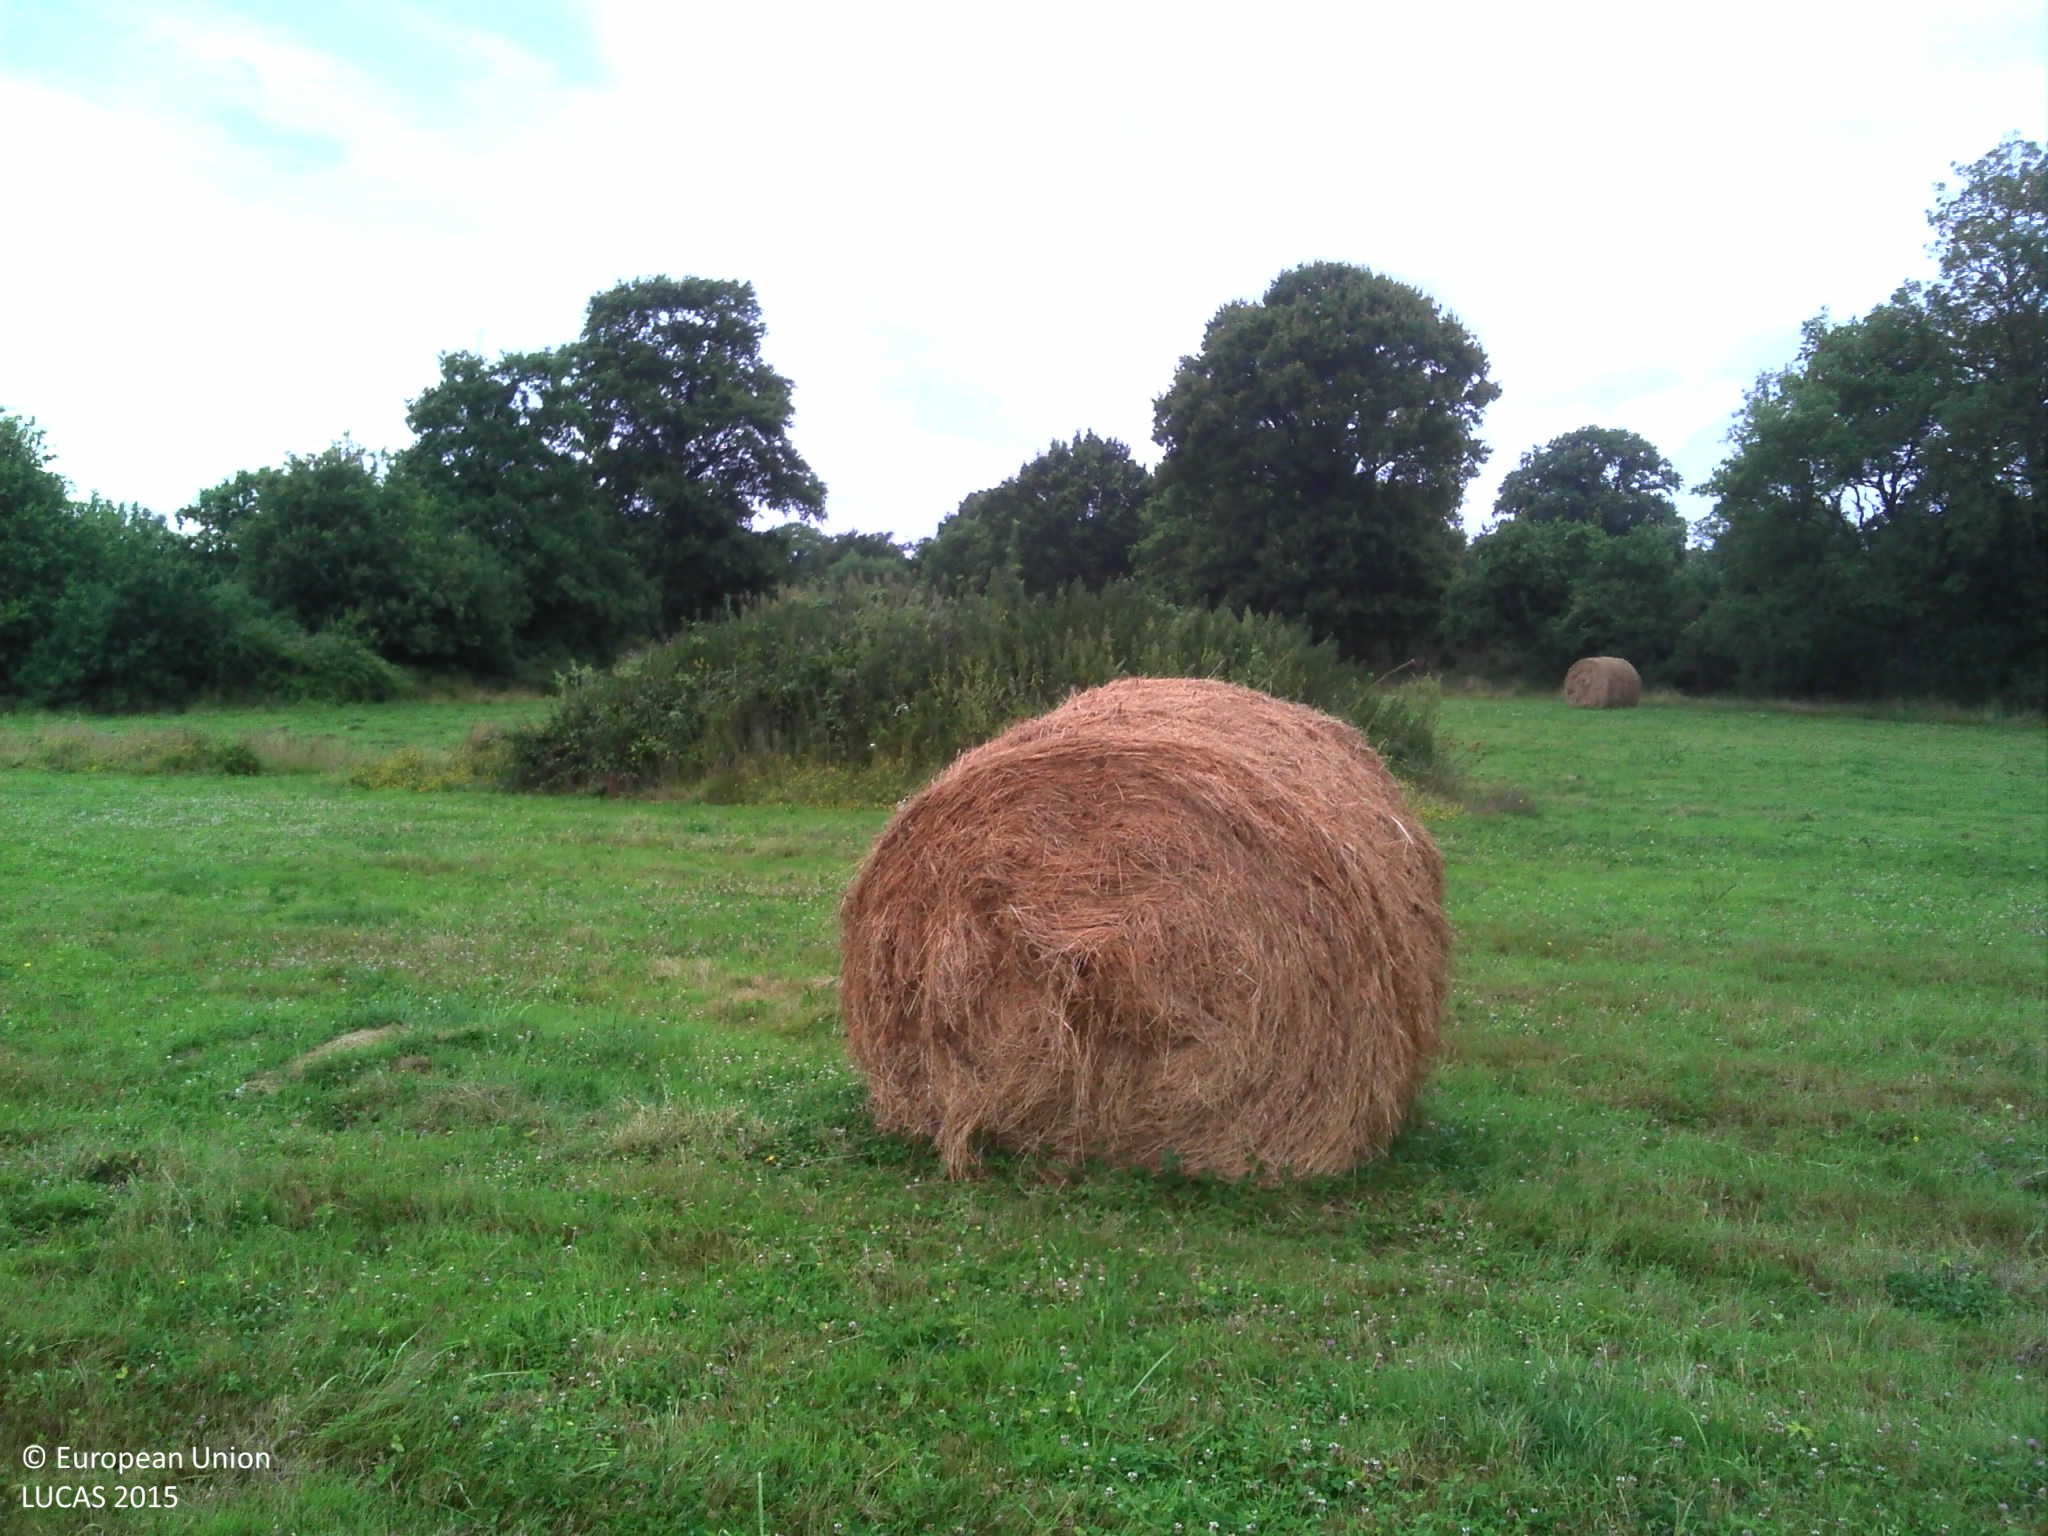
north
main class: Grassland
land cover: Grassland without tree/shrub cover
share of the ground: > 75 %
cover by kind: herbaceous plants 100 %
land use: Agriculture (excluding fallow land and kitchen gardens)
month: July
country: FR
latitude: 47.1839
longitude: -1.8300
